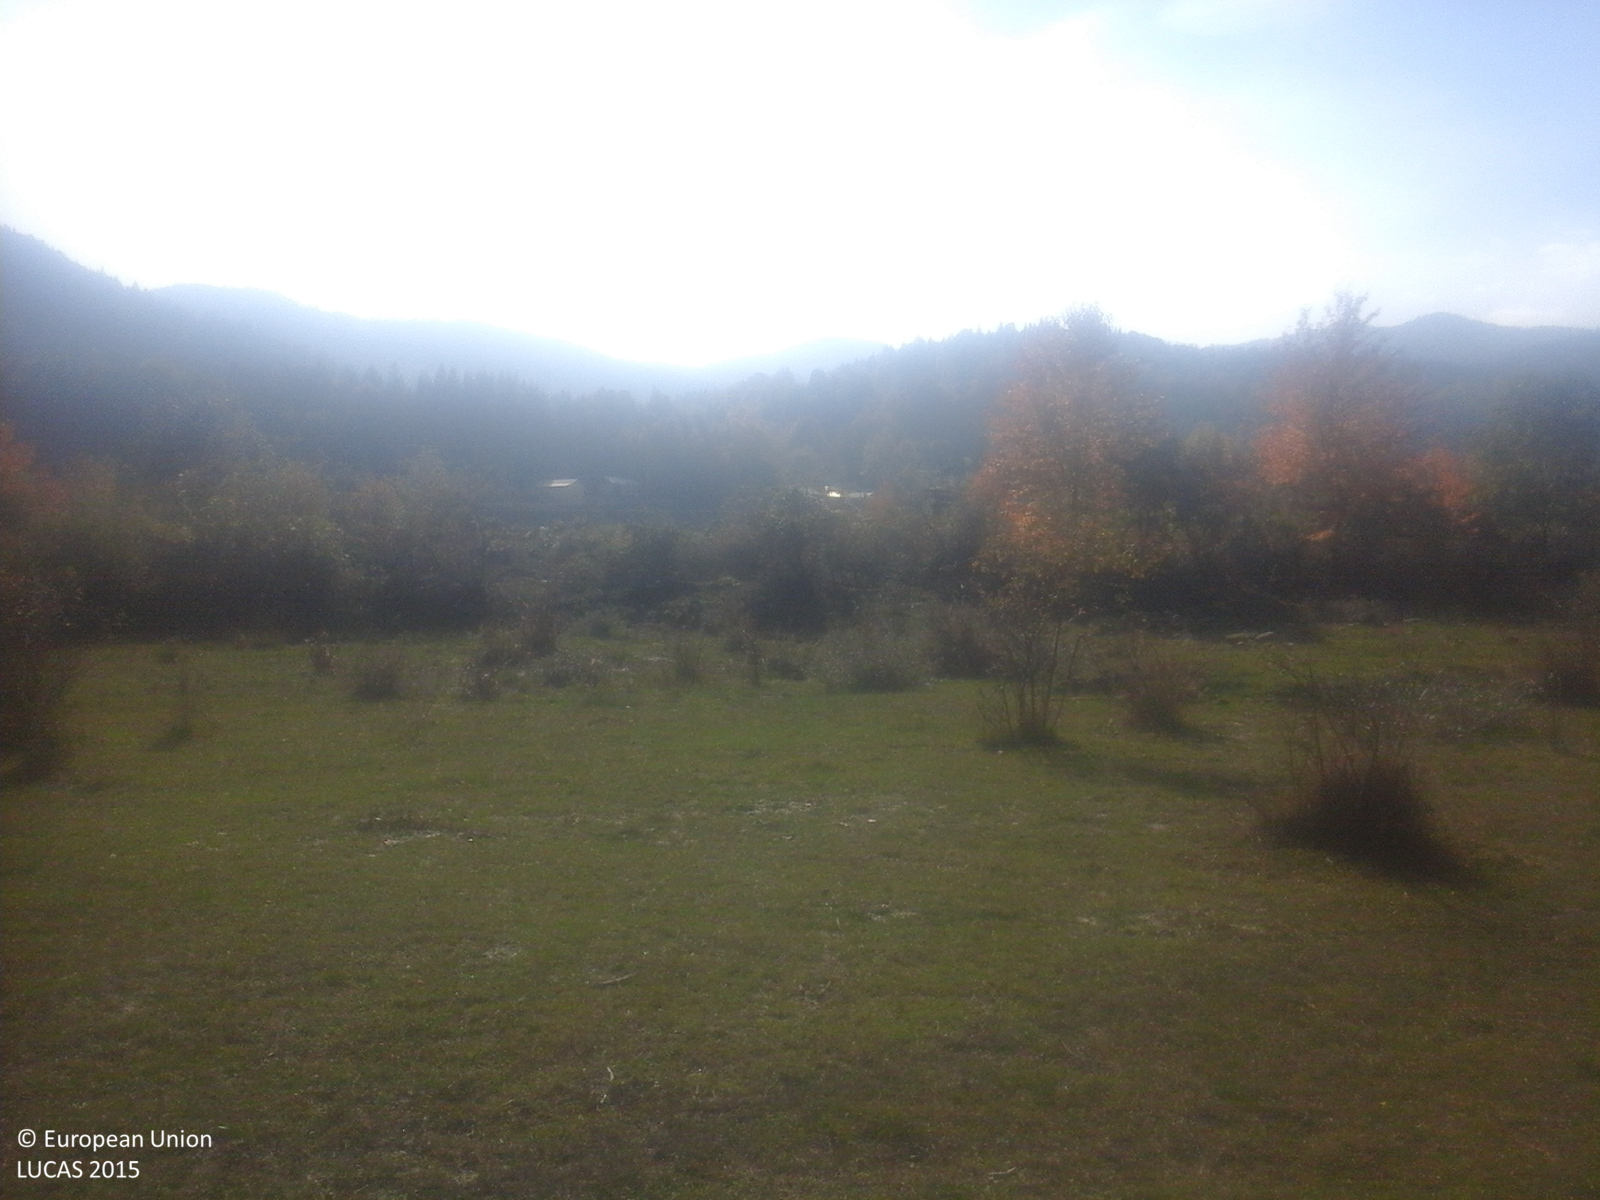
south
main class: Grassland
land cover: Grassland with sparse tree/shrub cover
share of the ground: > 75 %
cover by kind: herbaceous plants 85 %, shrubs 10 %, broadleaved forest trees 5 %
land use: Agriculture (excluding fallow land and kitchen gardens)
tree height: < 5 m
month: October
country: RO
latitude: 45.7080
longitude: 26.6897
